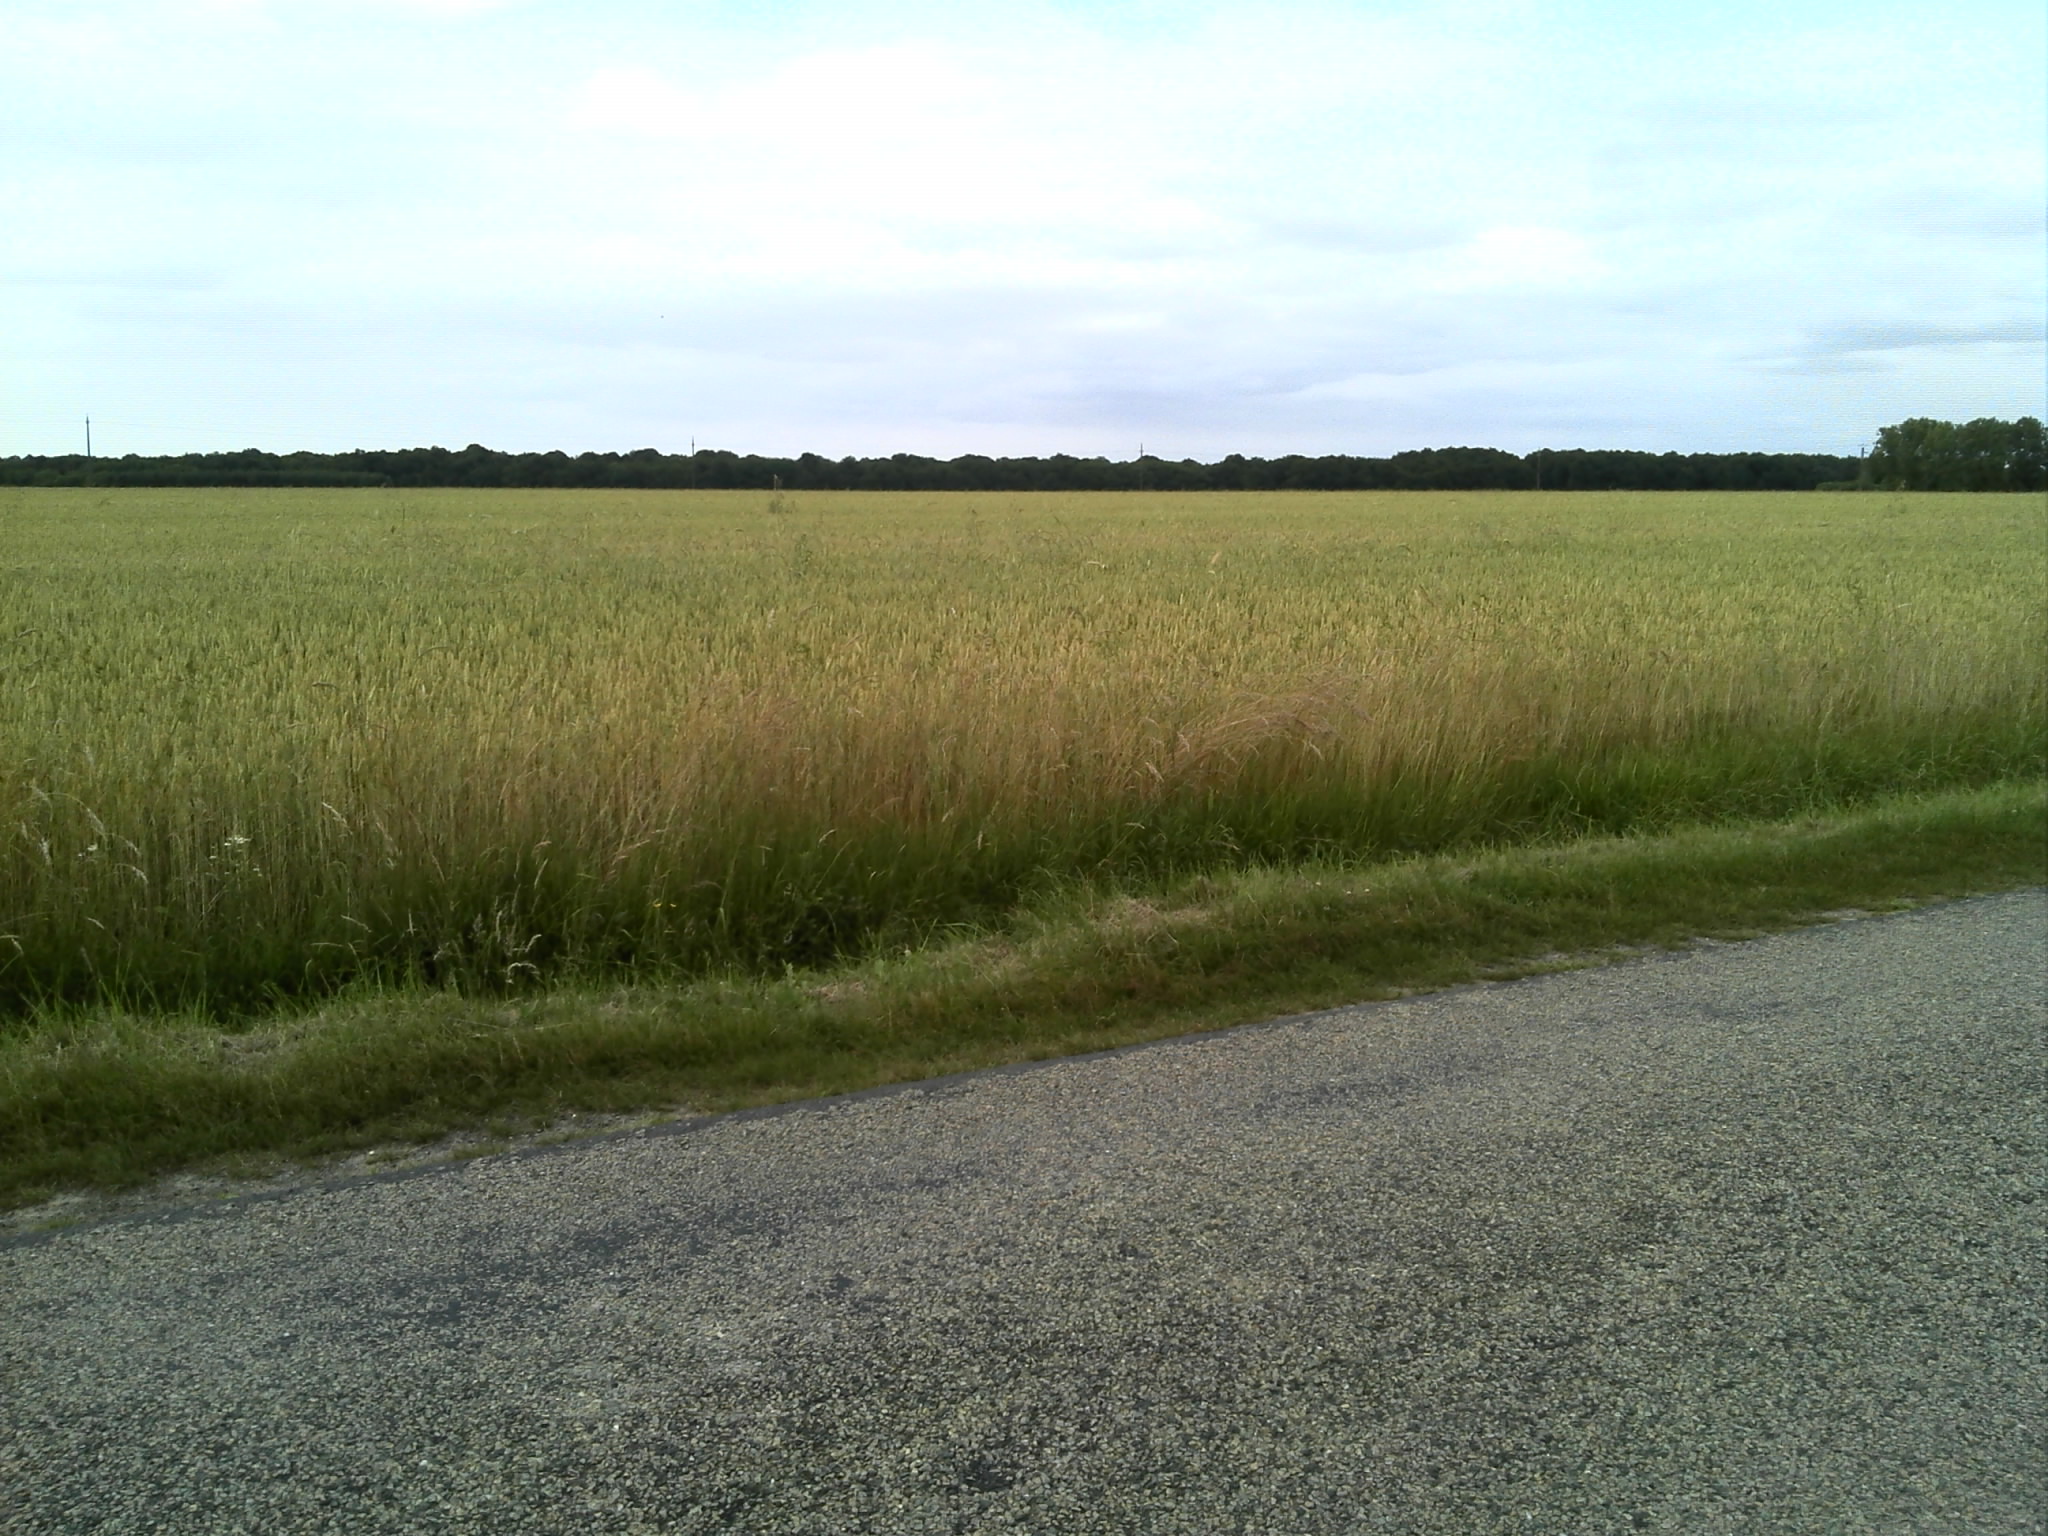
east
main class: Cropland
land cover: Rape and turnip rape
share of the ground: > 75 %
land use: Agriculture (excluding fallow land and kitchen gardens)
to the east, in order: Rape and turnip rape; Ditches and canals; Grass margins; Paved roads, cycling and walking lanes; Grass margins; Ditches and canals; Electric lines; Common wheat
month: June
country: FR
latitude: 47.1692
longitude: 1.4778
